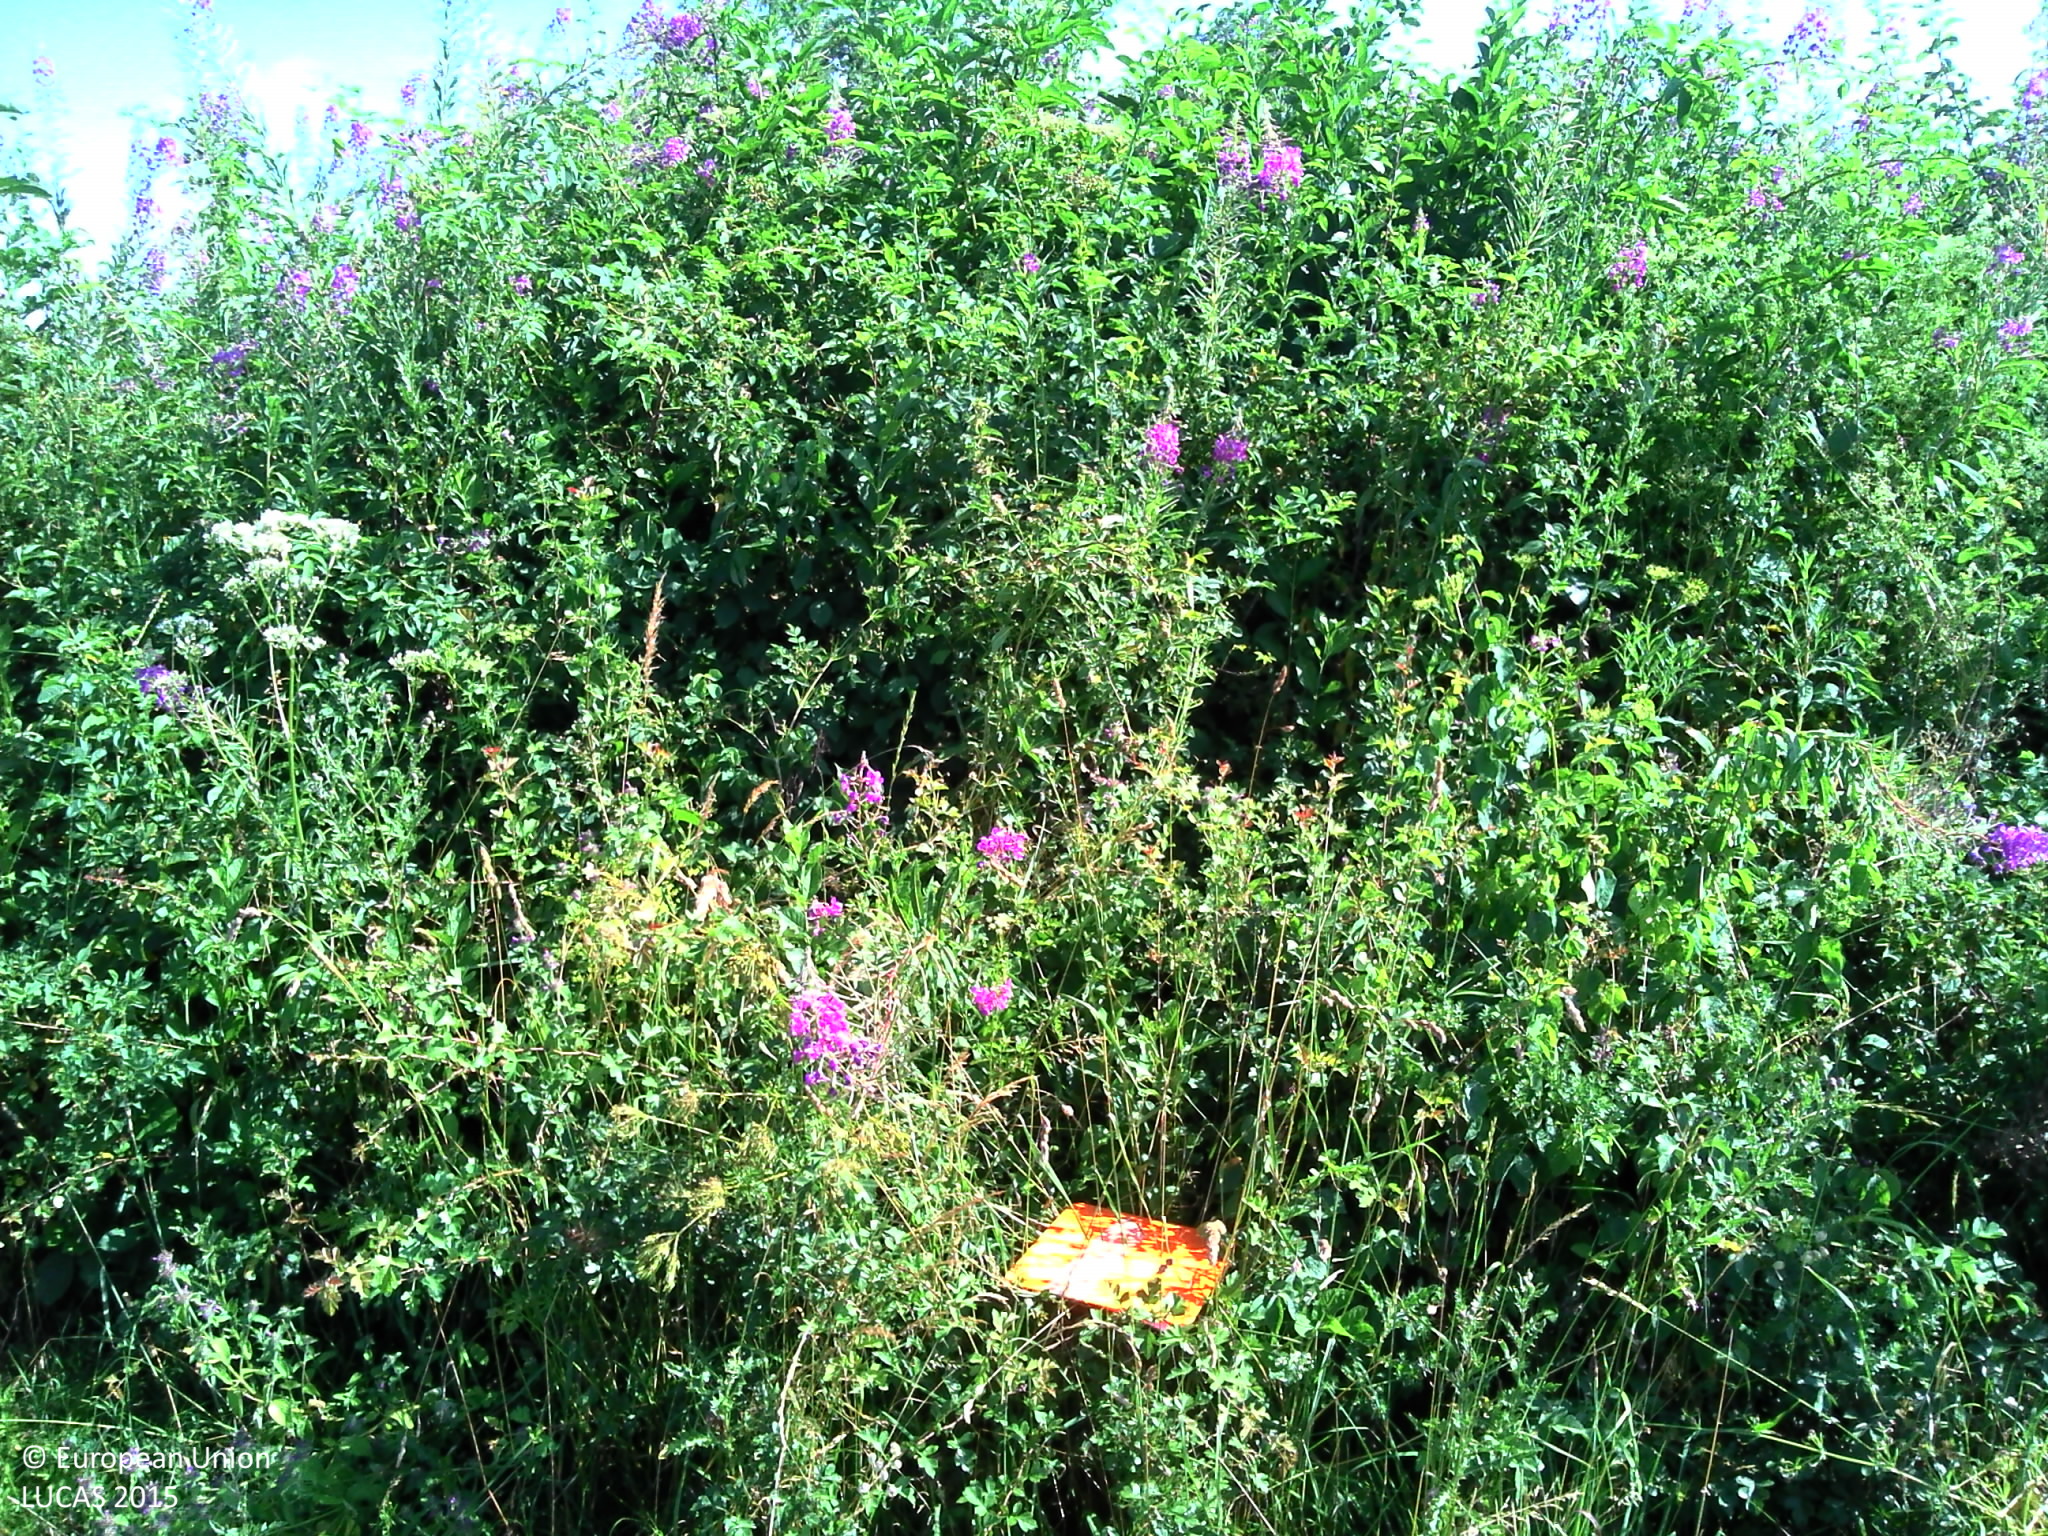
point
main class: Shrubland
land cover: Shrubland without tree cover
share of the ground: > 75 %
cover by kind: shrubs 100 %
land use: Agriculture (excluding fallow land and kitchen gardens)
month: July
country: FR
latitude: 46.7863
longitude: 6.1383
